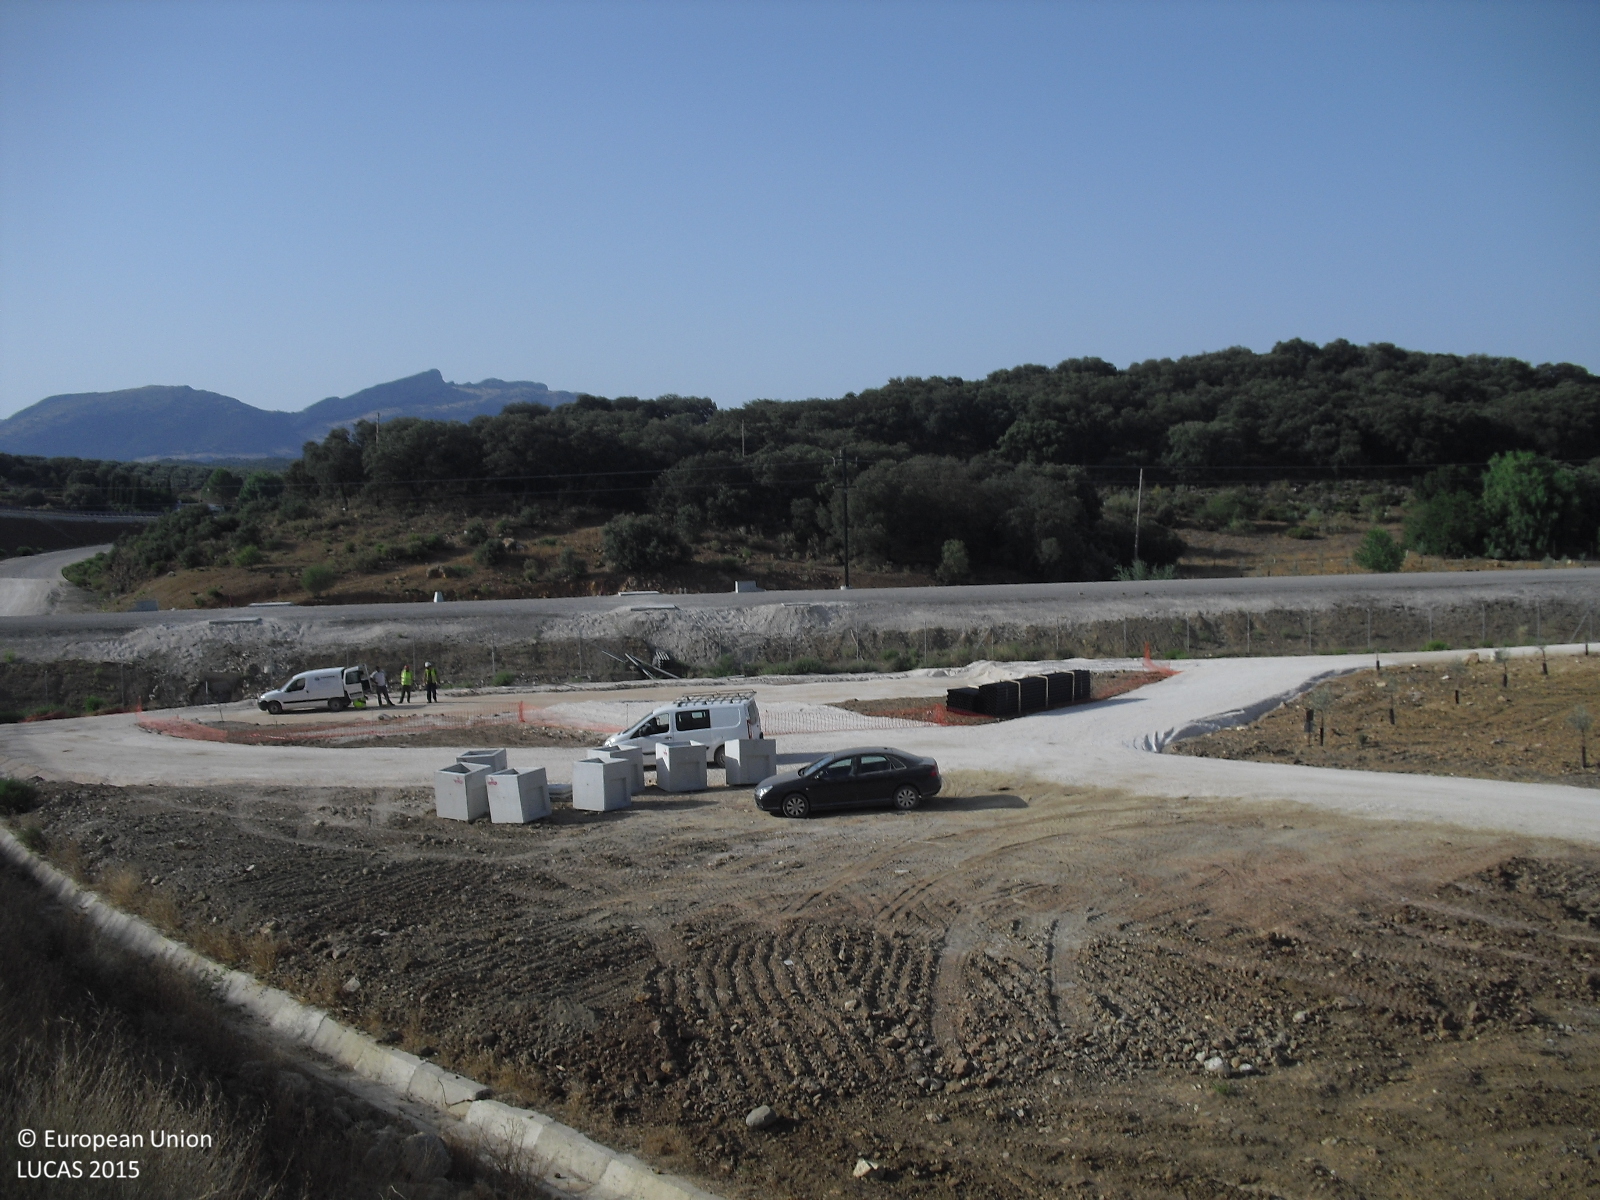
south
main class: Grassland
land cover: Grassland without tree/shrub cover
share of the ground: 25 - 50 %
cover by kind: unconsolidated bare surface 65 %, herbaceous plants 35 %
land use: Protection infrastructures
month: July
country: ES
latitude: 37.1381
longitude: -4.3040
